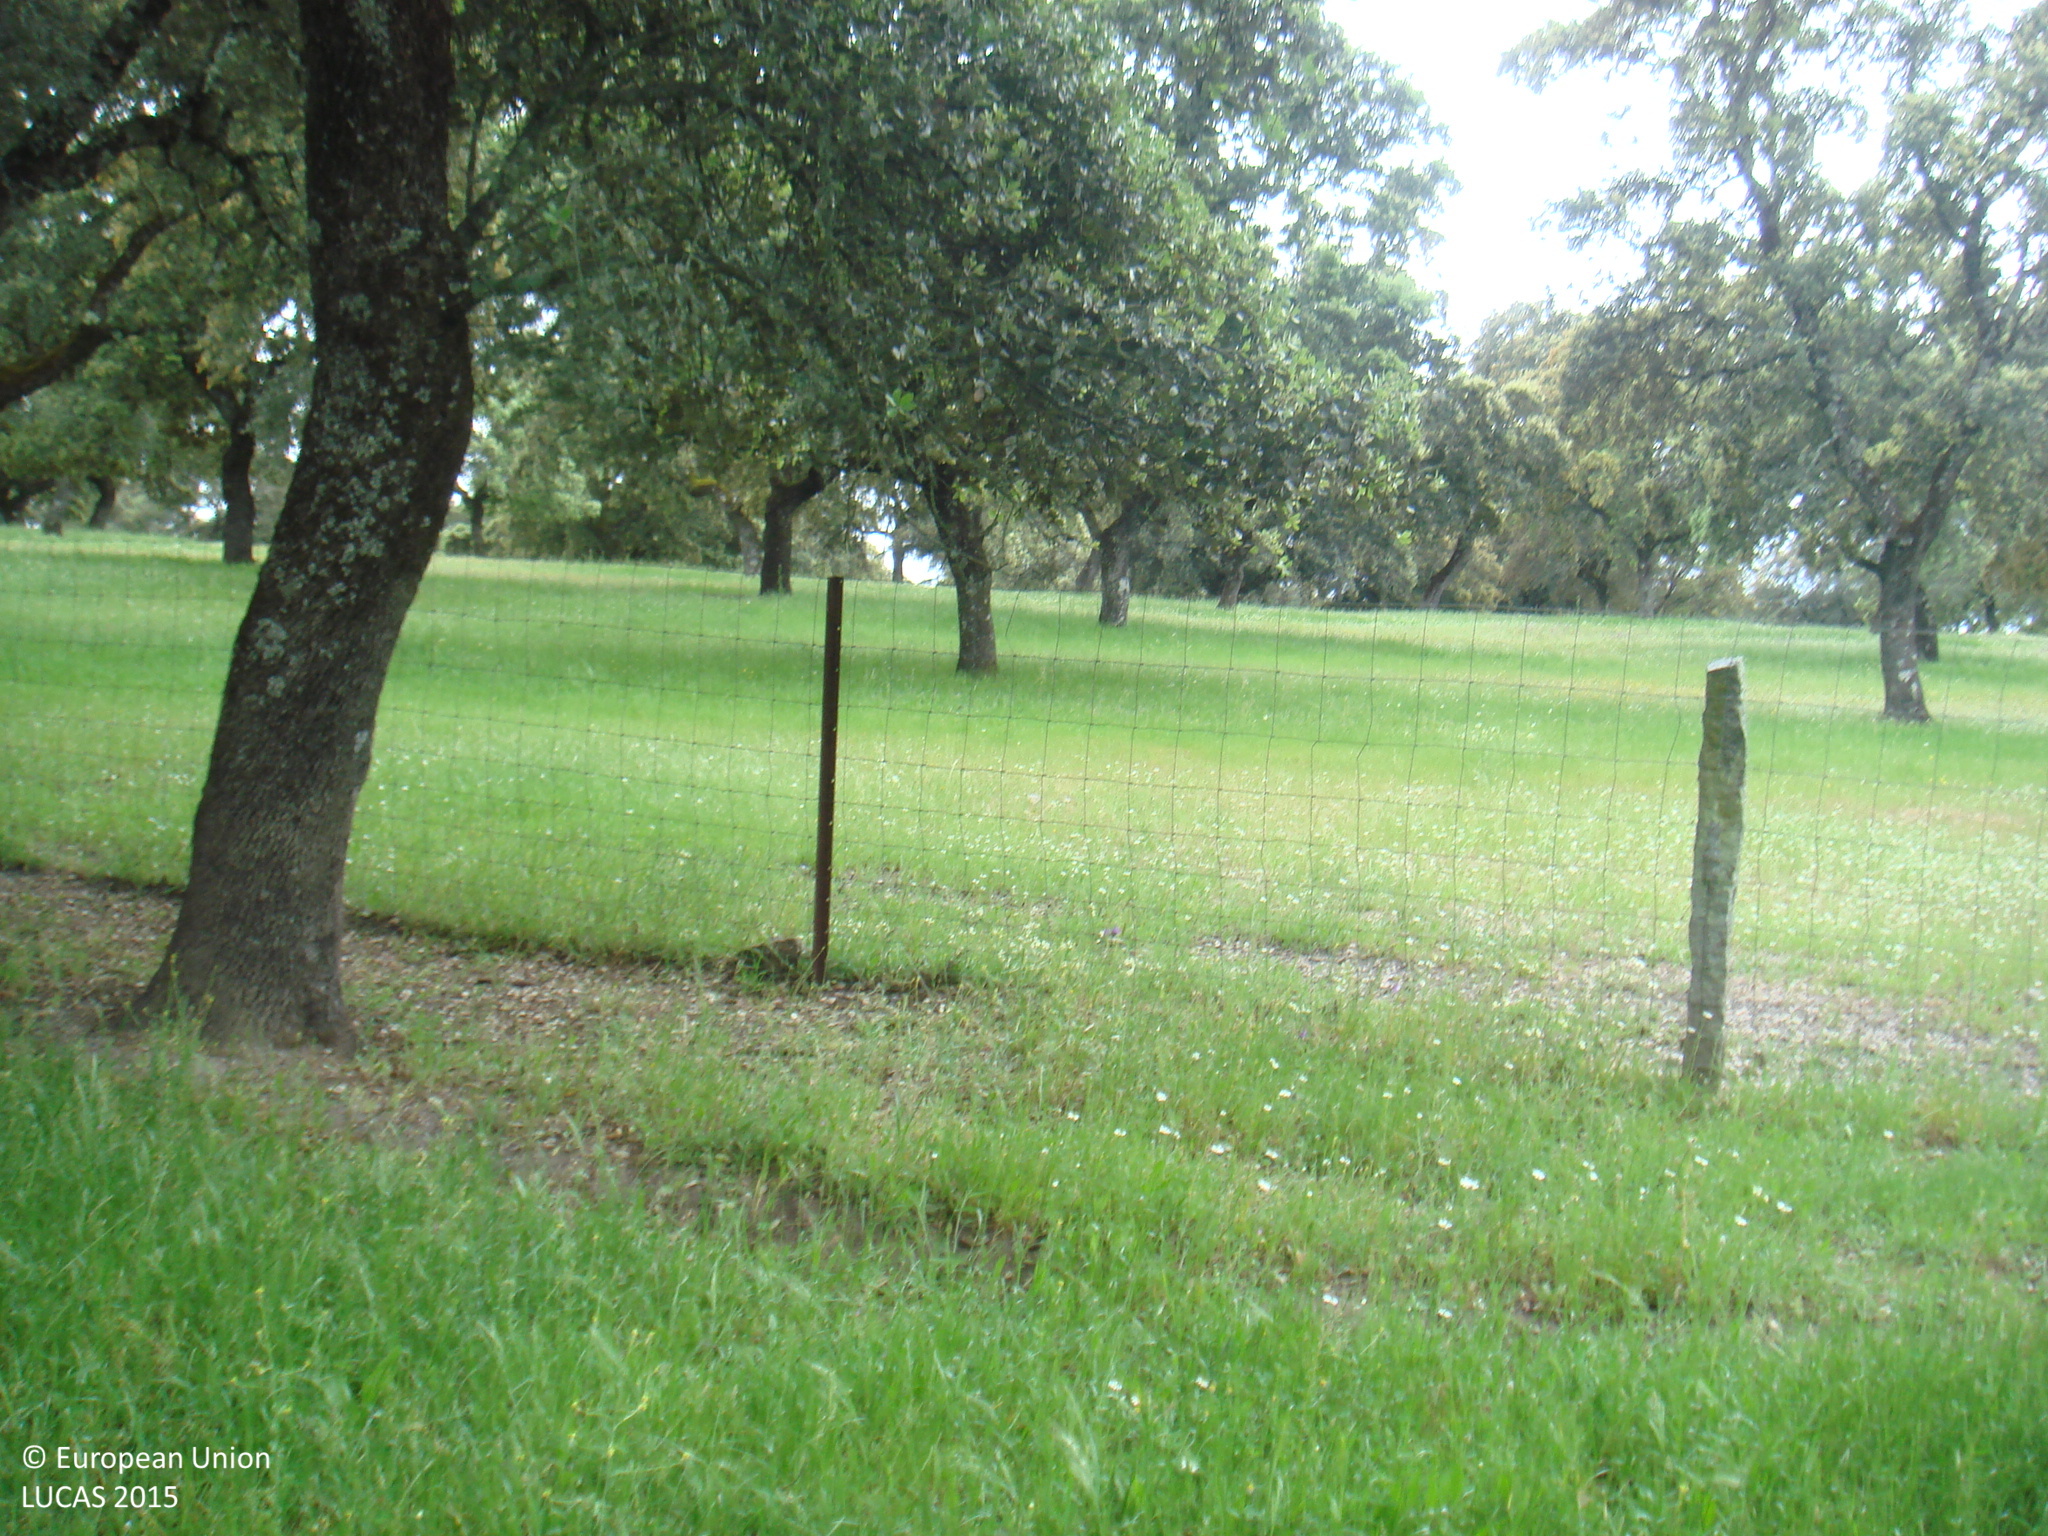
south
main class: Woodland
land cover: Broadleaved woodland
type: broadleaved evergreen forest
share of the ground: > 75 %
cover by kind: herbaceous plants 60 %, broadleaved forest trees 40 %
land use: Forestry
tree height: > 5 m
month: April
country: ES
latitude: 38.2366
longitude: -4.3295
